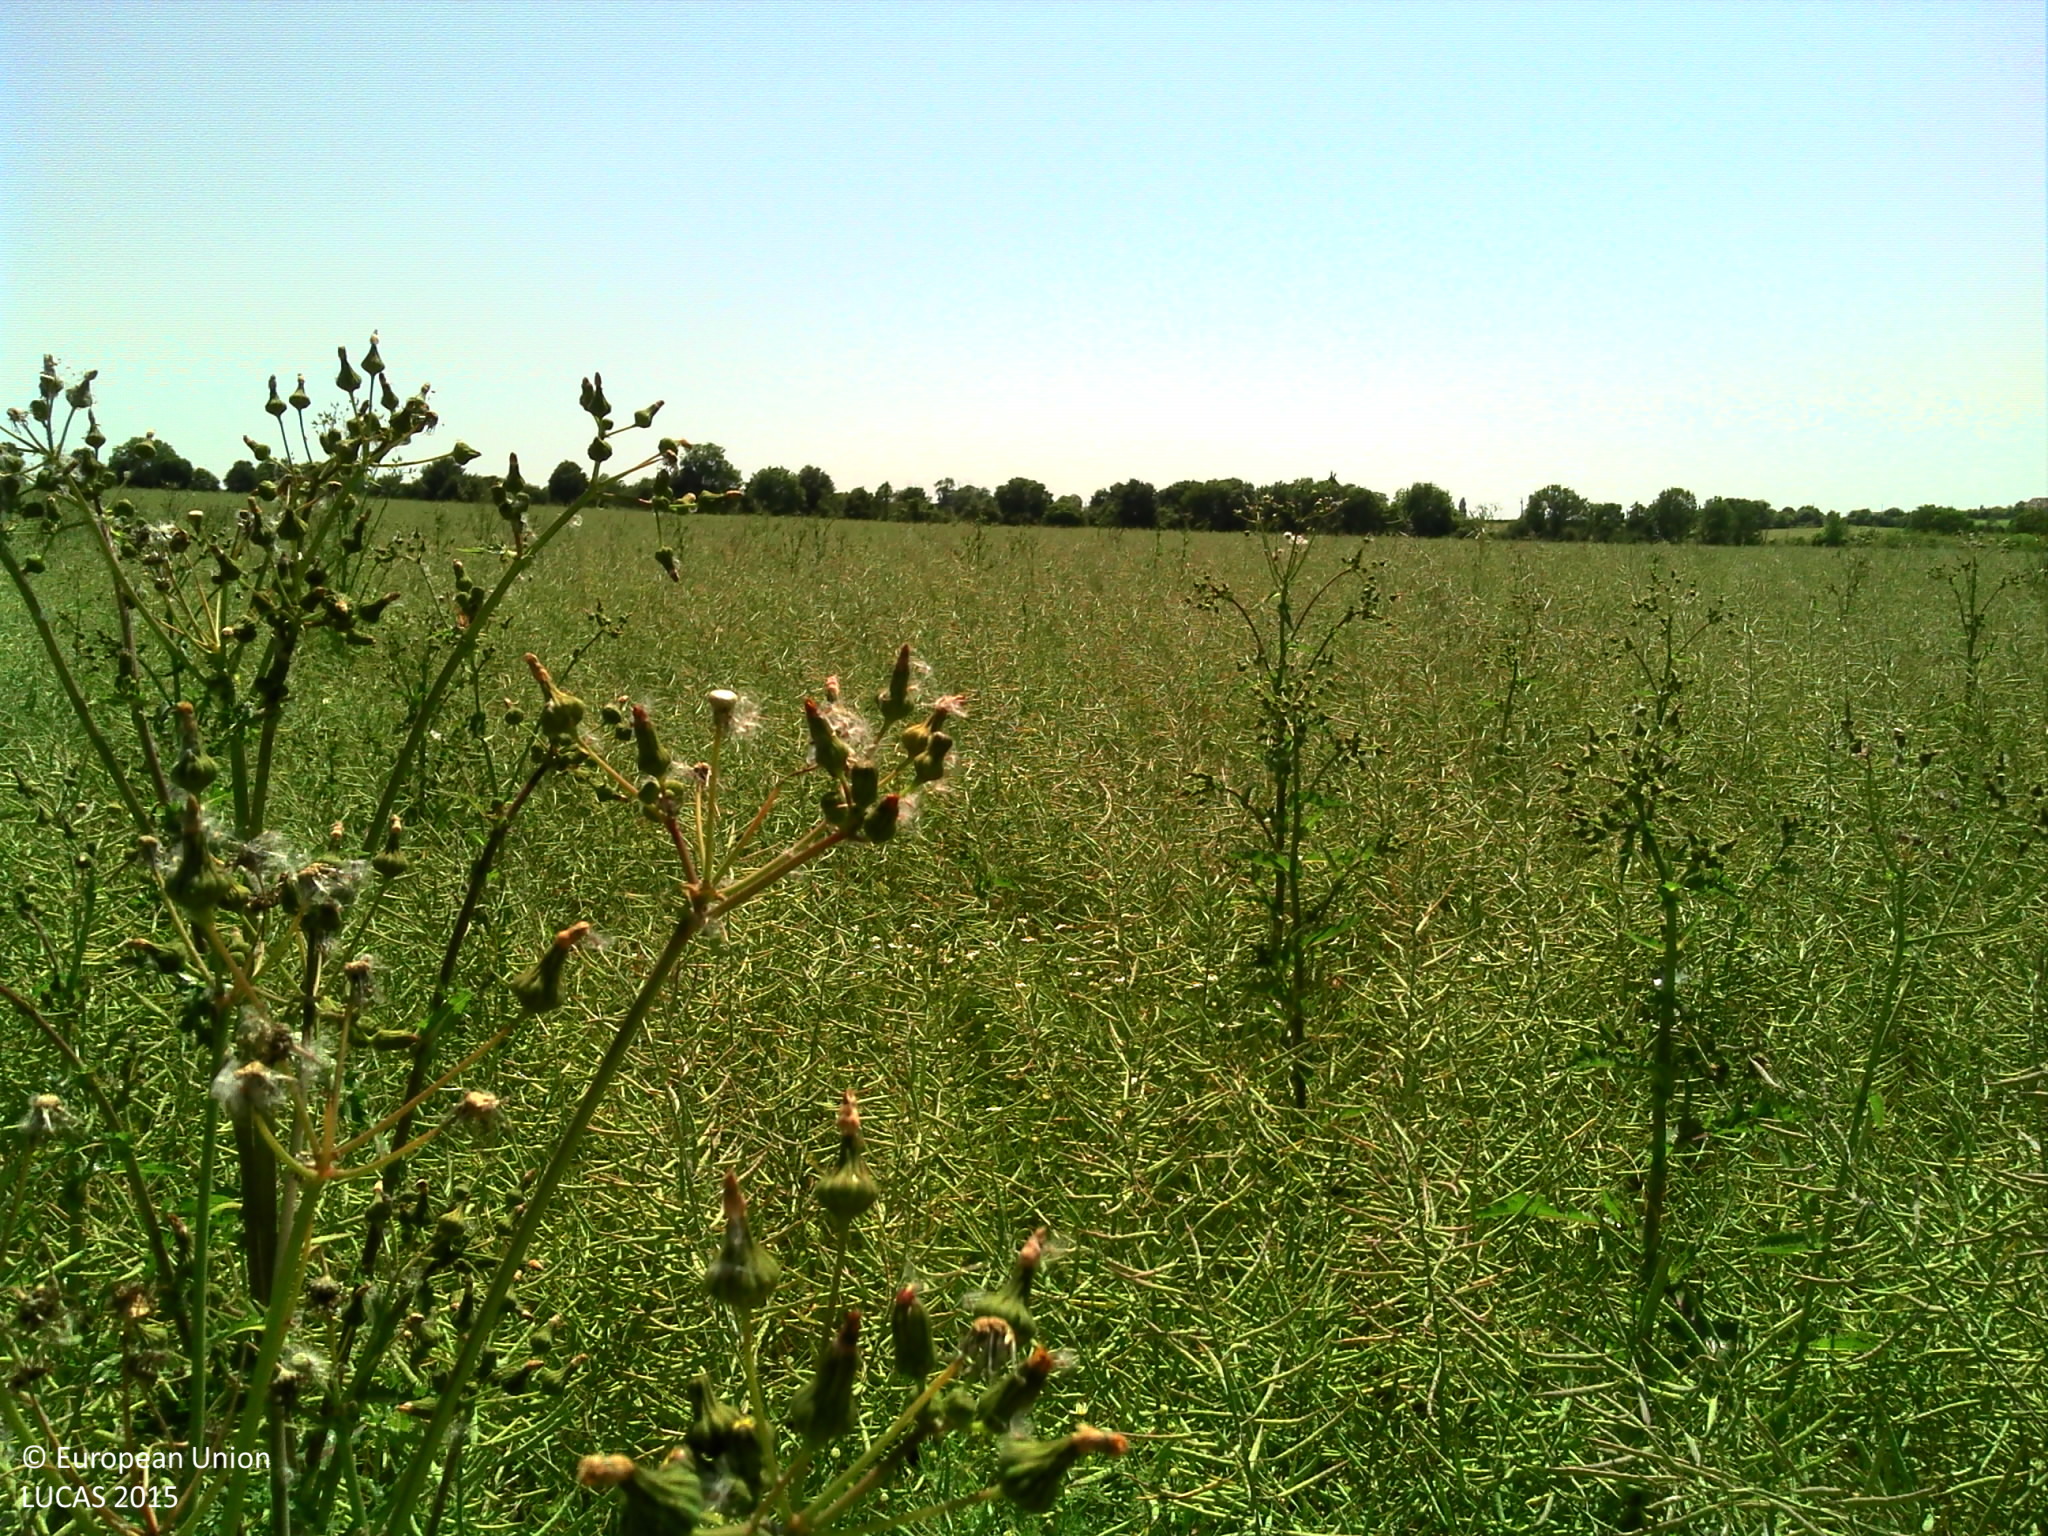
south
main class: Cropland
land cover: Rape and turnip rape
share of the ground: > 75 %
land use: Agriculture (excluding fallow land and kitchen gardens)
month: June
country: FR
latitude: 46.9030
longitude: 2.7881
